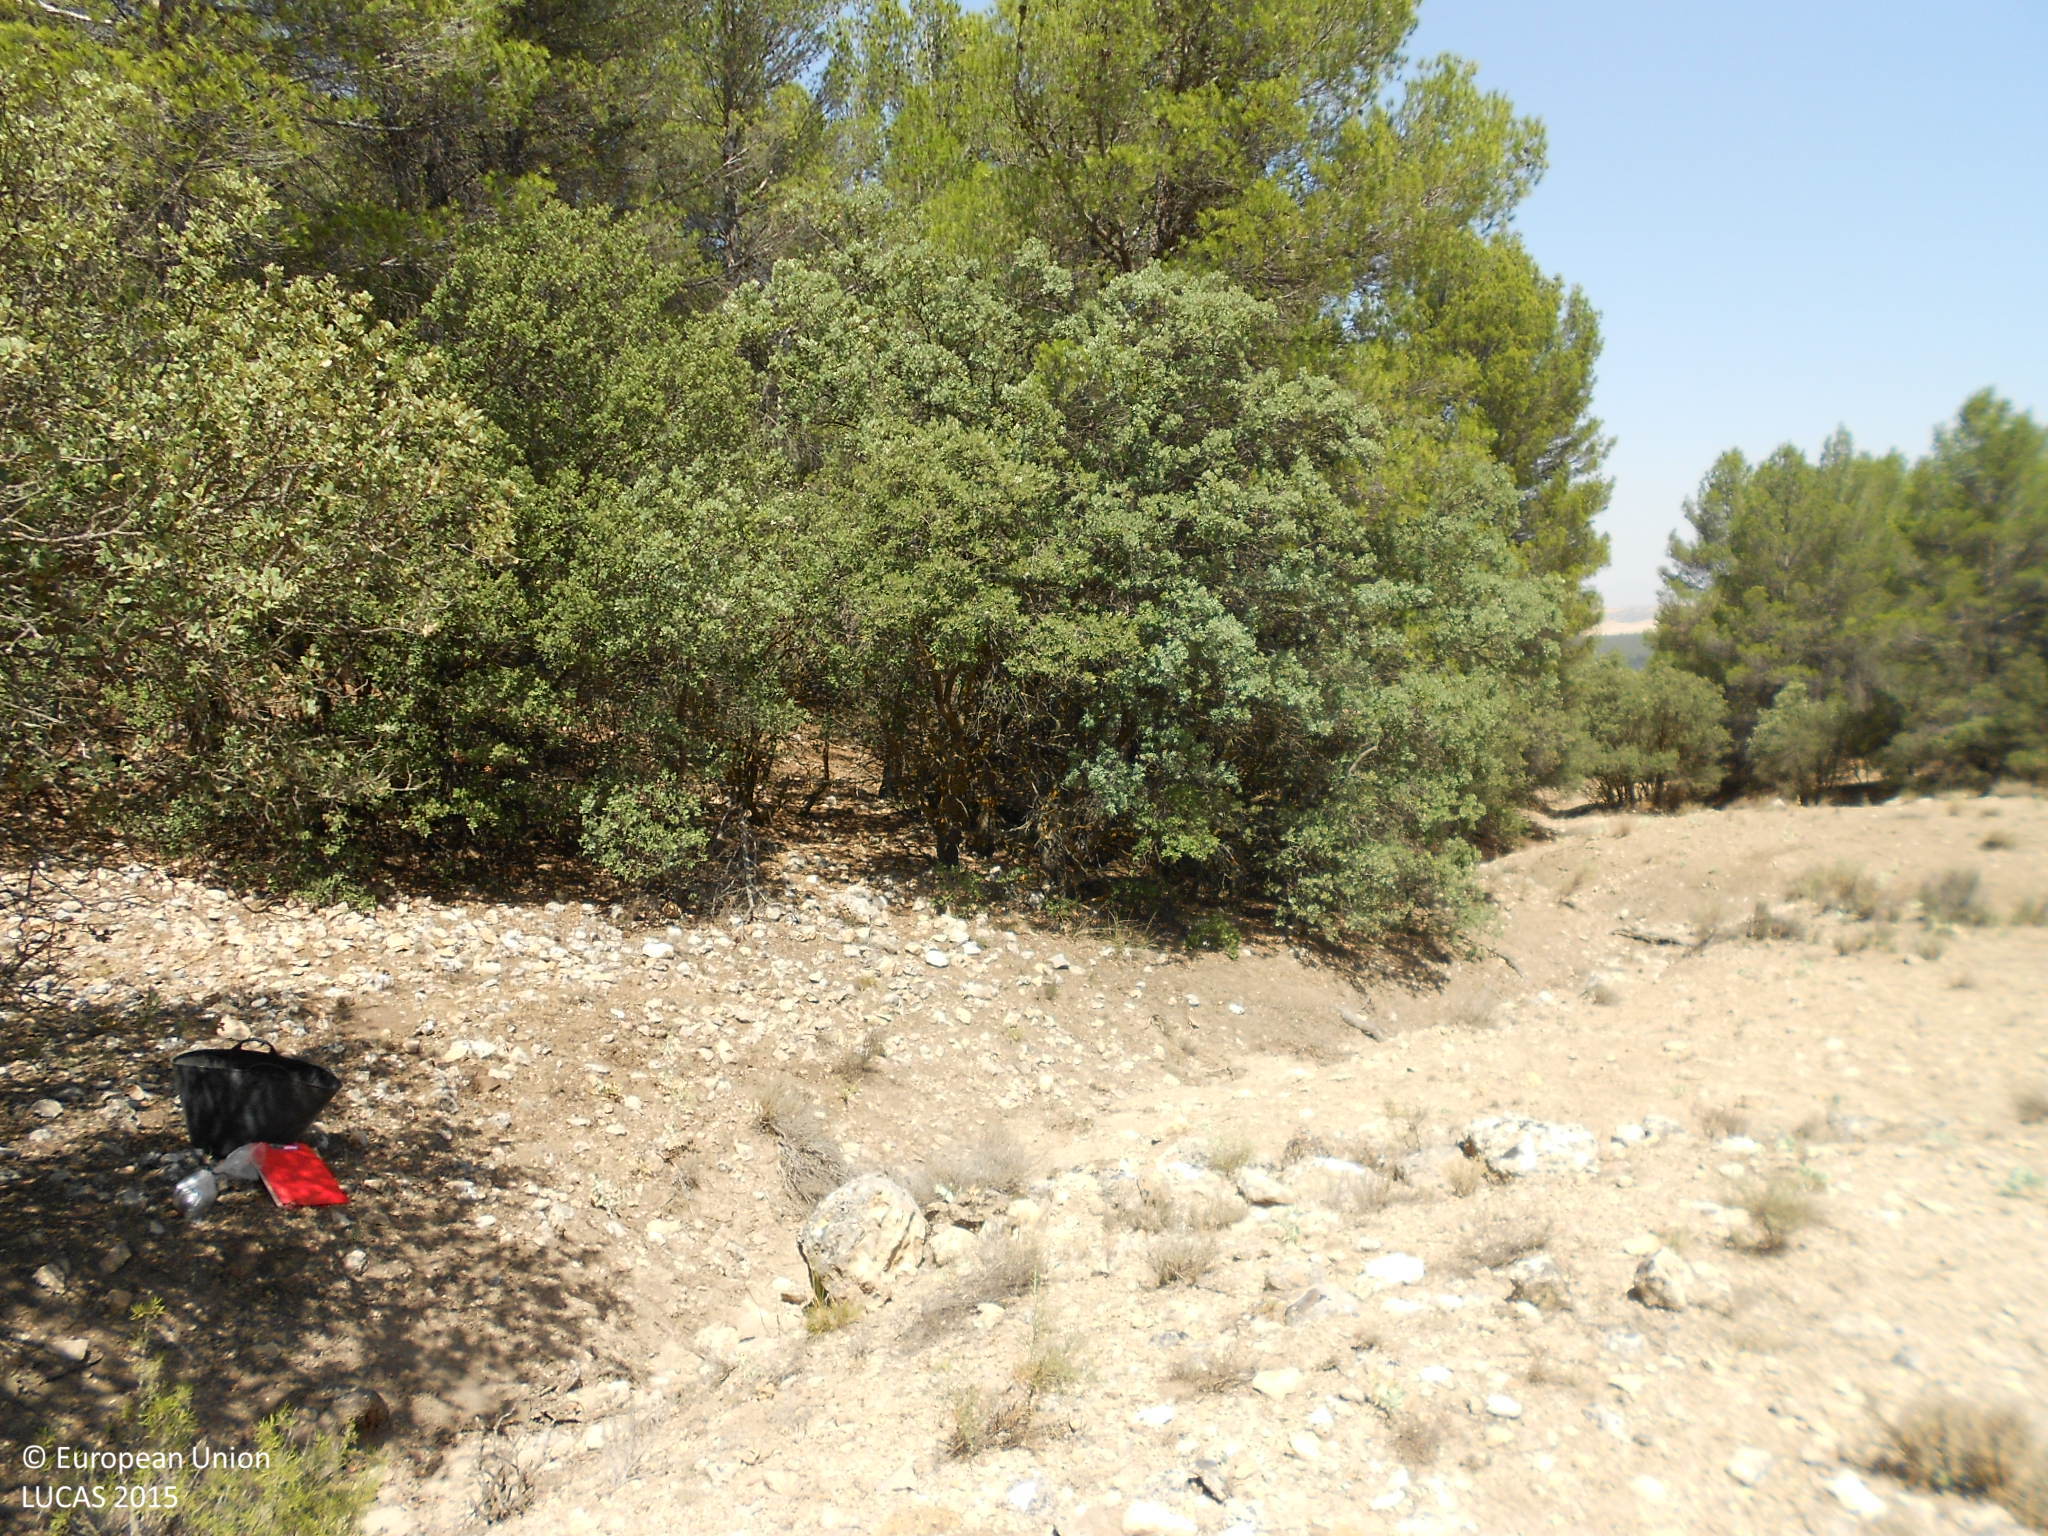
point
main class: Woodland
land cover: Other mixed woodland
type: coniferous forest of the mediterranean region
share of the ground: > 75 %
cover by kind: coniferous forest trees 40 %, broadleaved forest trees 40 %, shrubs 20 %
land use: Semi-natural and natural areas not in use
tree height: > 5 m
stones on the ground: 25 - 50 %
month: August
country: ES
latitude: 37.6859
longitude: -2.2443
